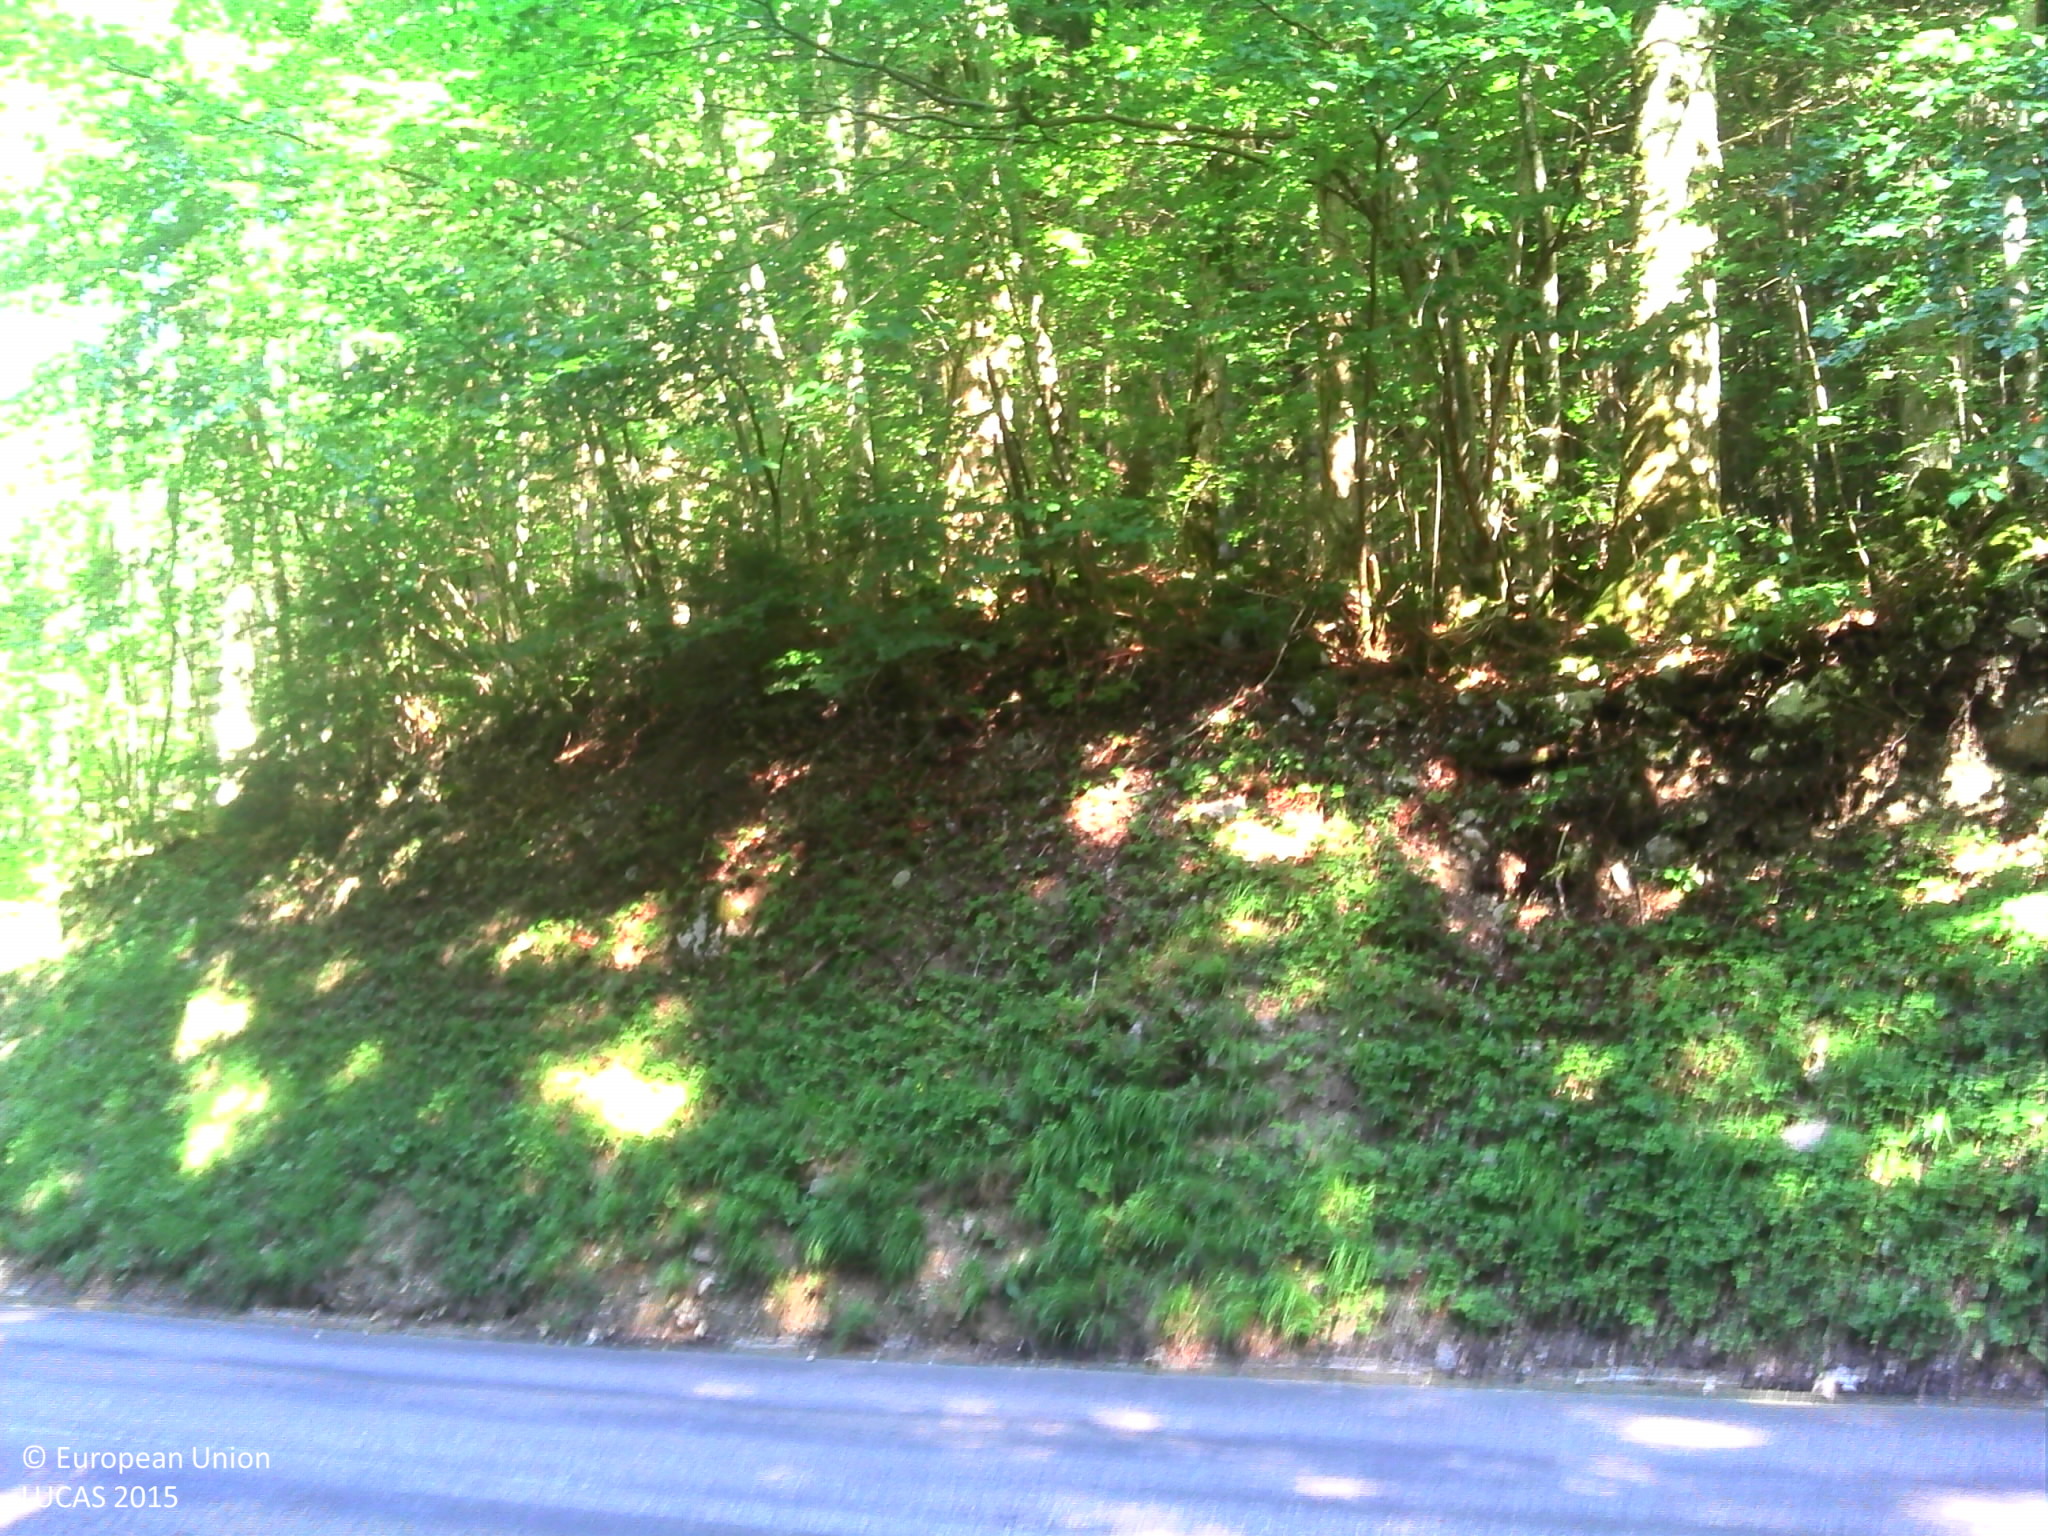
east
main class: Woodland
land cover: Spruce dominated coniferous woodland
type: hemiboreal forest and nemoral coniferous forest and mixed broadleaved-coniferous forest
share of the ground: > 75 %
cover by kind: coniferous forest trees 95 %, unconsolidated bare surface 5 %
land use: Forestry
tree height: > 5 m
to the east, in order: Spruce dominated coniferous woodland; Grass margins; Tracks; Grass margins; Other mixed woodland
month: June
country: FR
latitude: 45.0823
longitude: 5.4702
